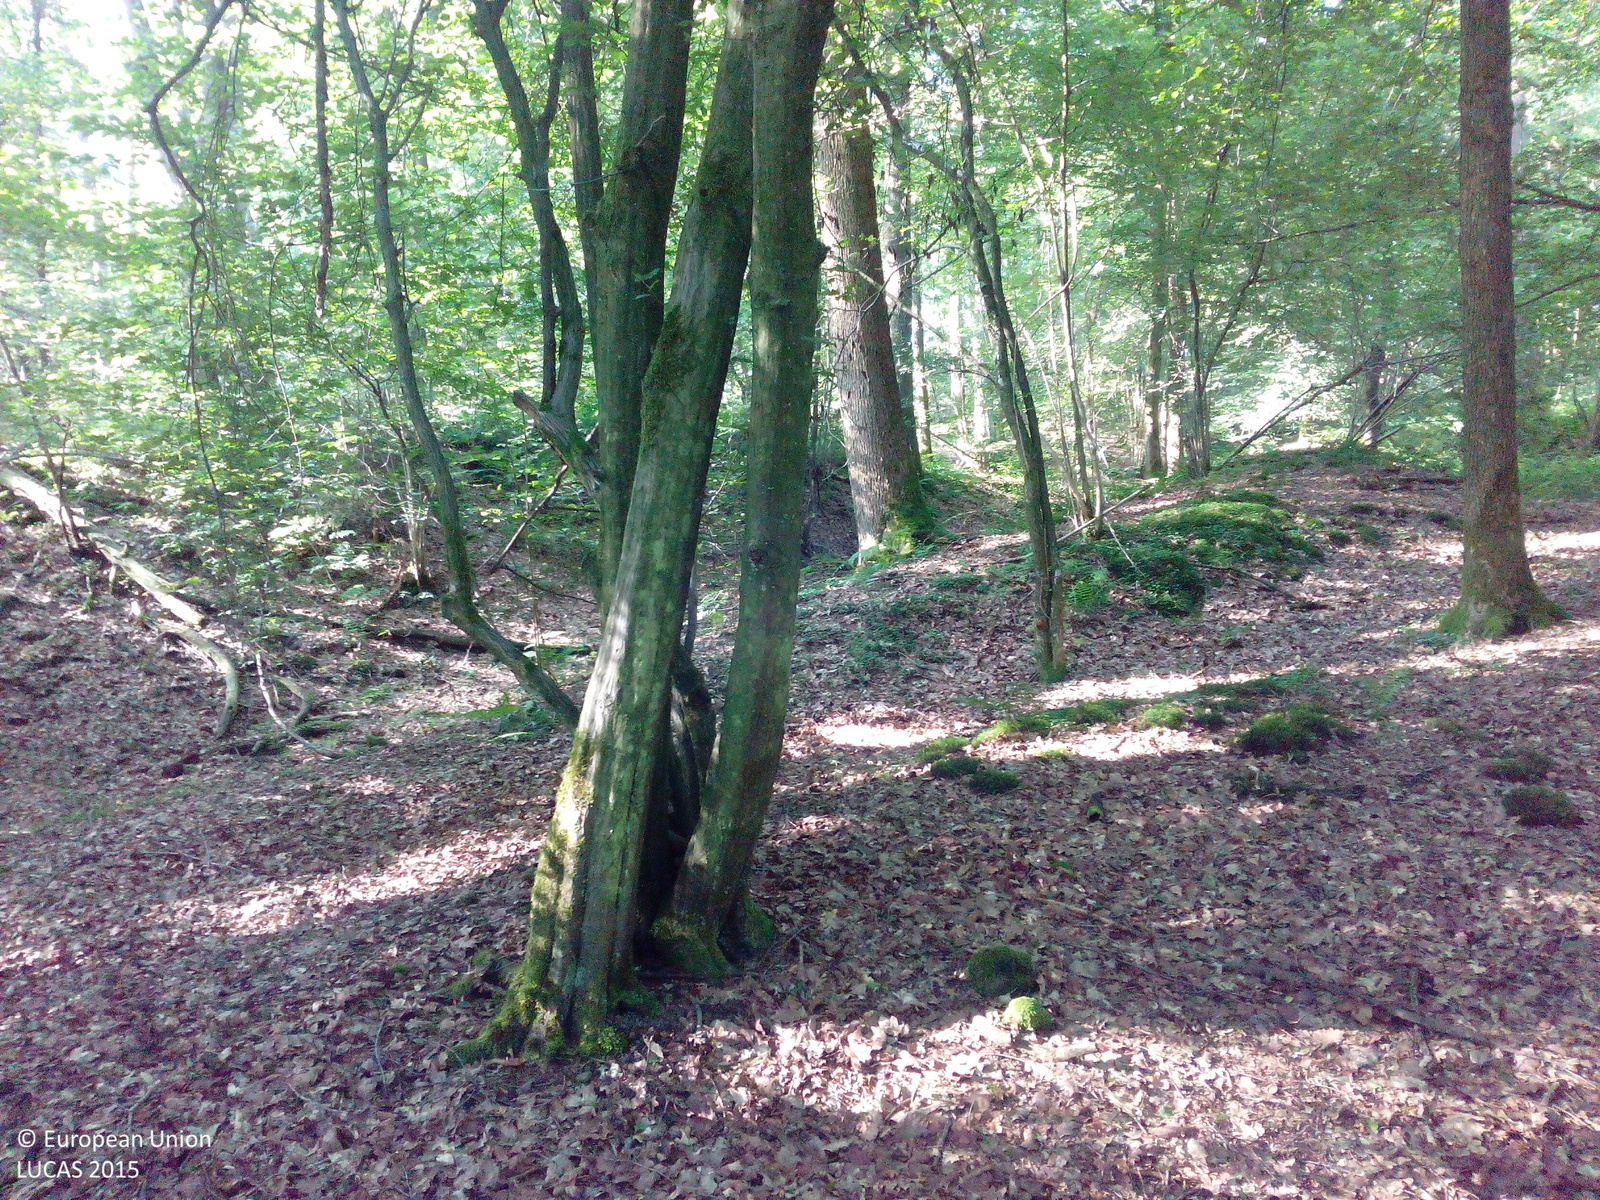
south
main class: Woodland
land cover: Broadleaved woodland
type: mesophytic deciduous forest
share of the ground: > 75 %
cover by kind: broadleaved forest trees 85 %, coniferous forest trees 15 %
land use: Forestry
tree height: > 5 m
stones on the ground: < 10 %
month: June
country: DE
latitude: 50.8748
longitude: 7.4279
